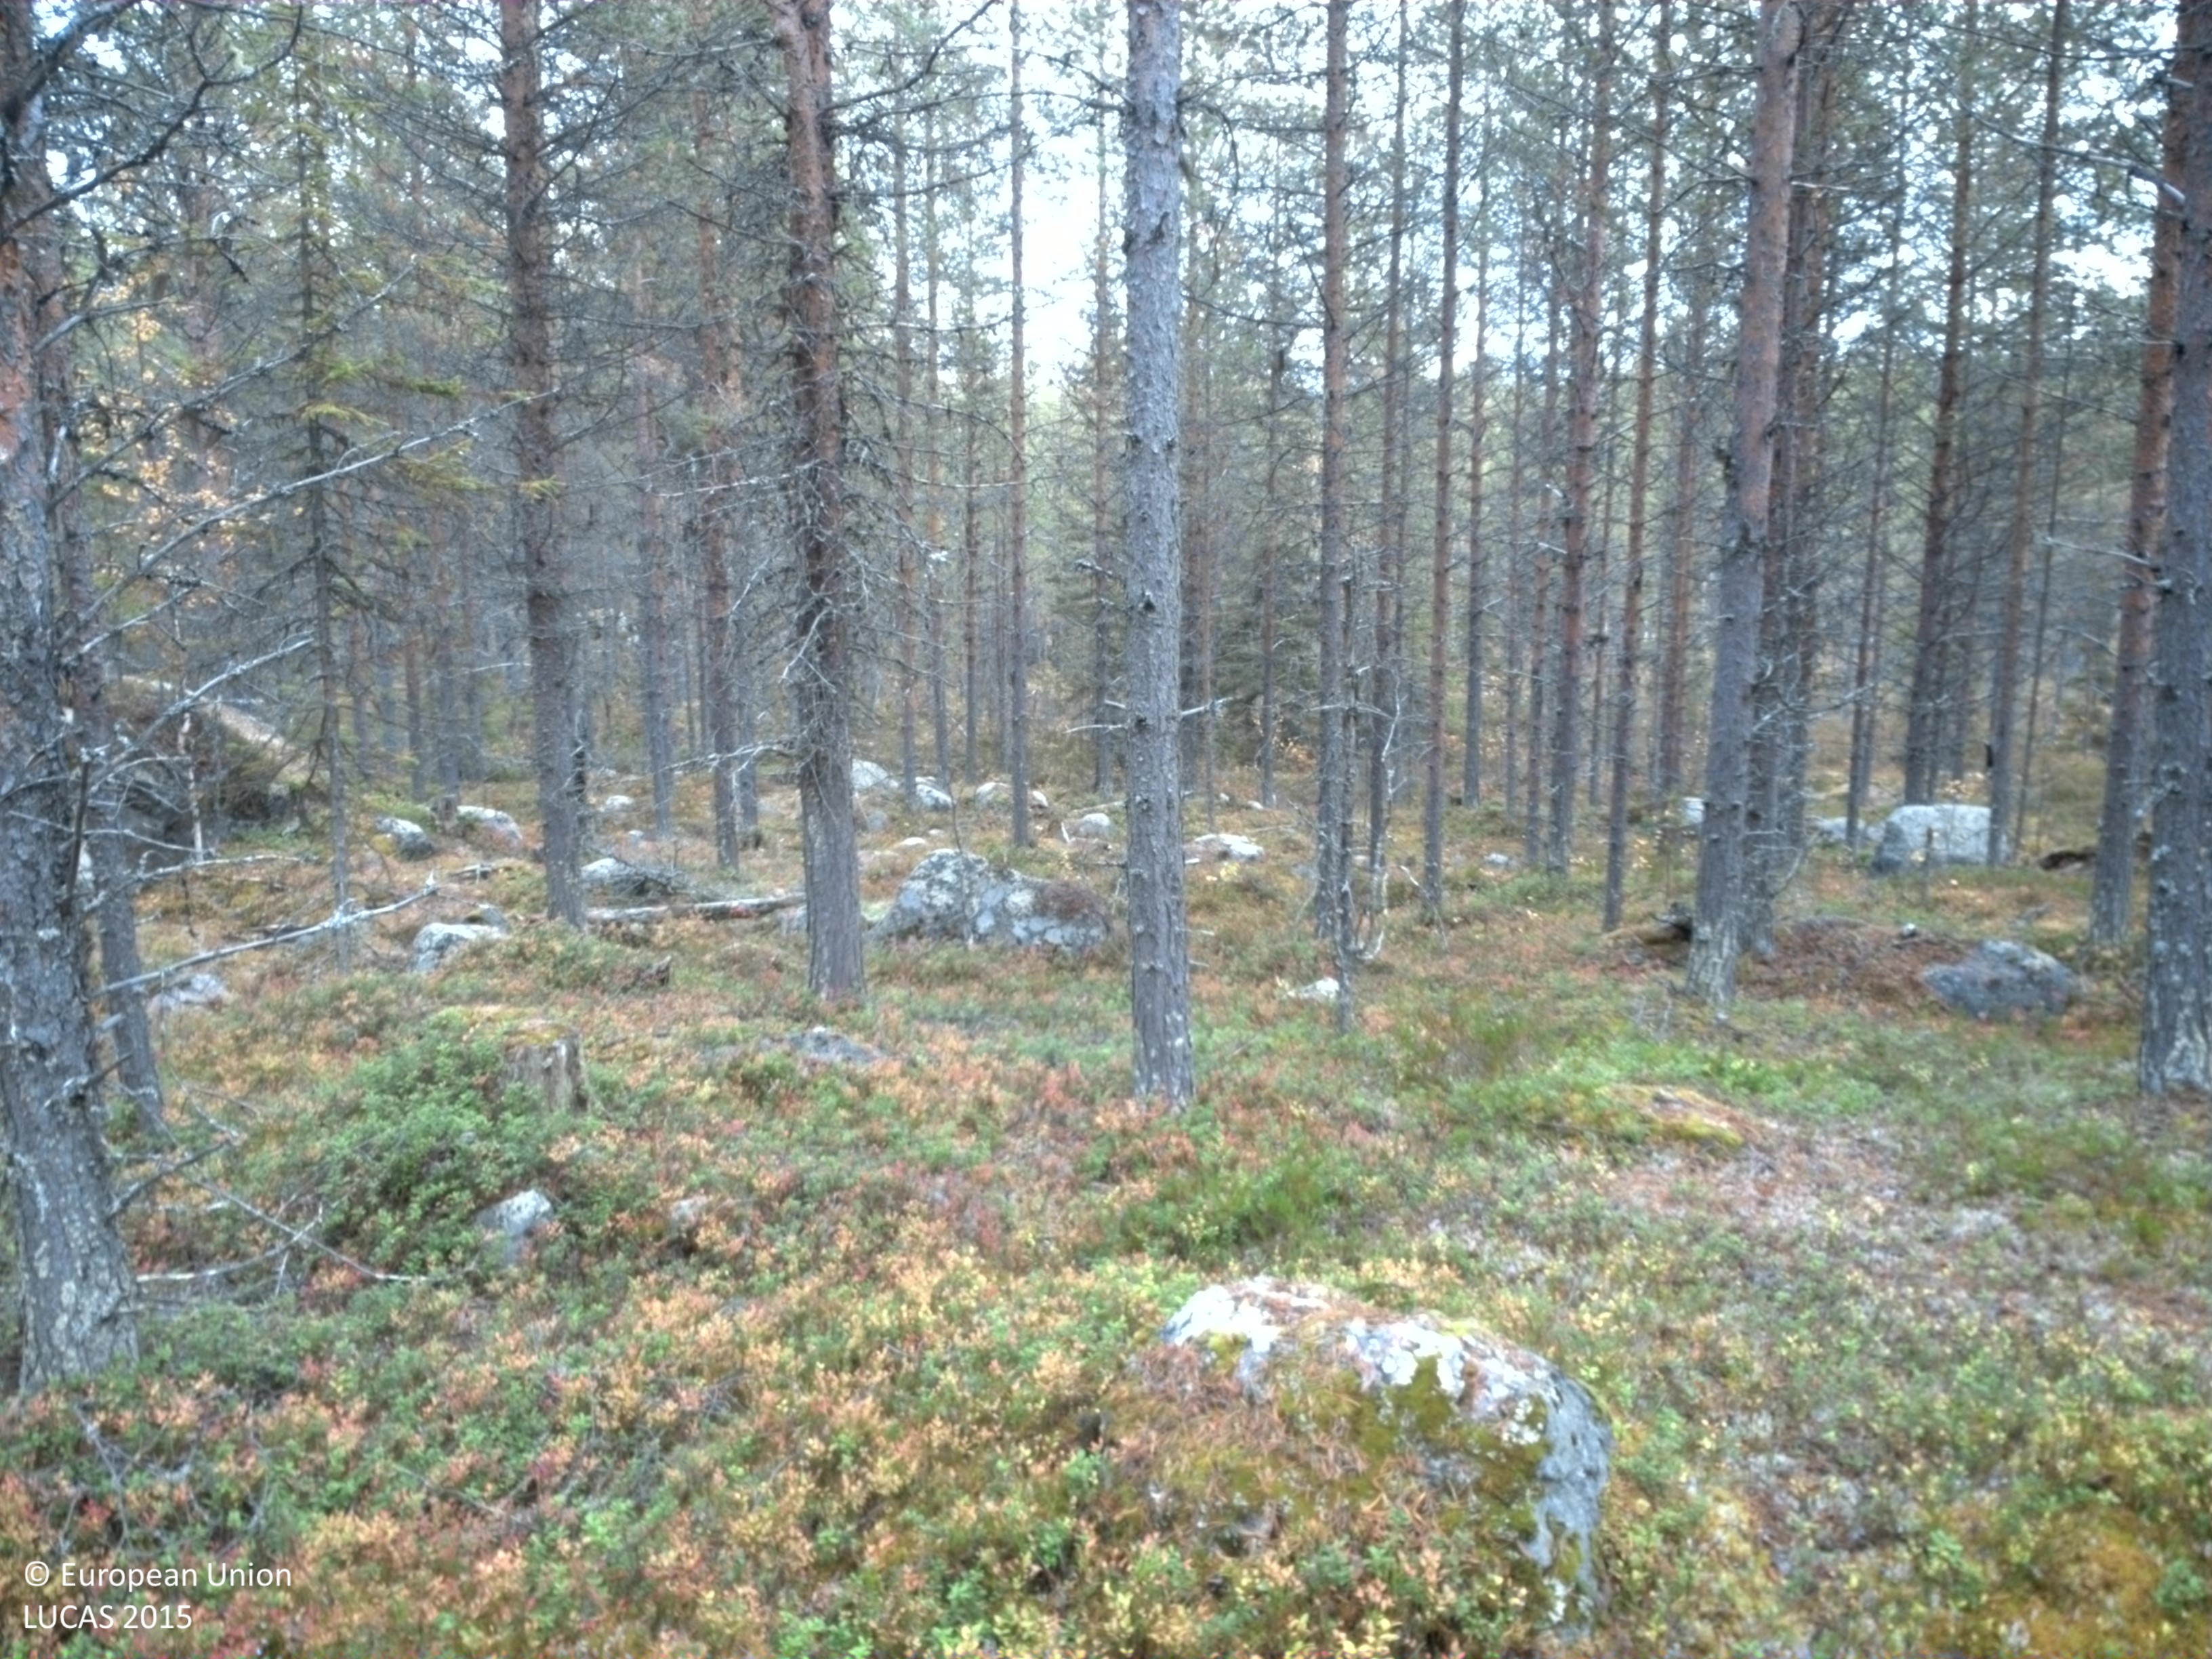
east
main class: Woodland
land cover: Pine dominated coniferous woodland
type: boreal forest
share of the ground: 25 - 50 %
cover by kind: shrubs 35 %, coniferous forest trees 30 %, lichens and mosses 30 %, consolidated bare surface 5 %
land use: Forestry
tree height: > 5 m
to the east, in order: Pine dominated coniferous woodland; Other mixed woodland; Pine dominated coniferous woodland
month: September
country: SE
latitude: 65.0597
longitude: 17.8059
